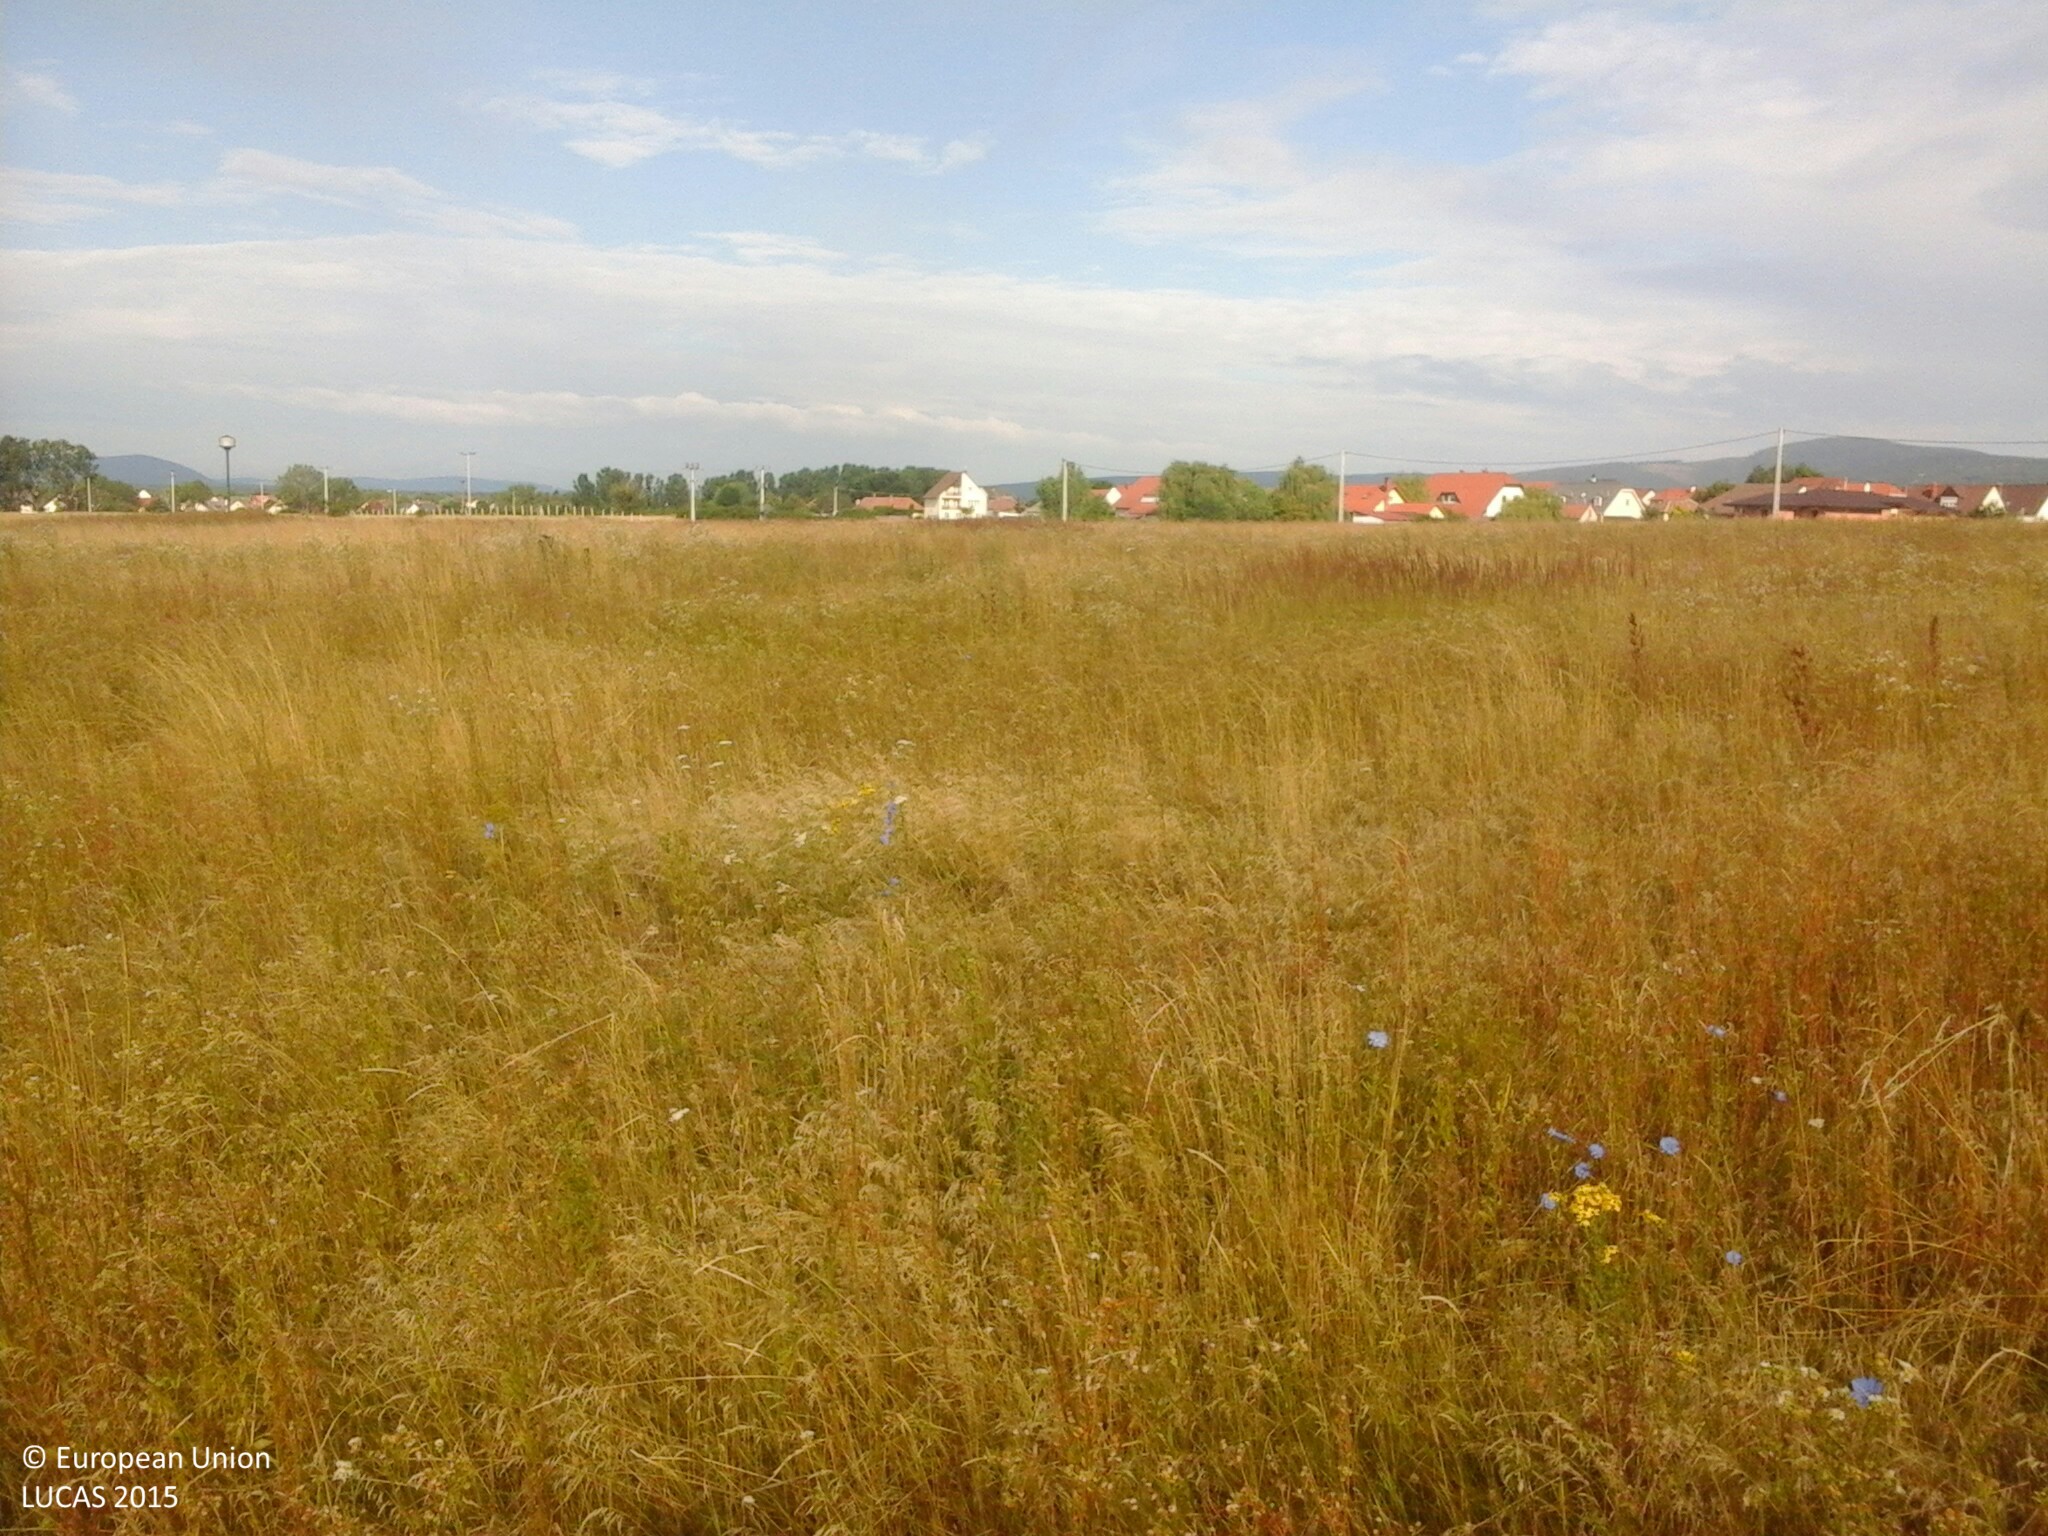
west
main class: Grassland
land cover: Grassland without tree/shrub cover
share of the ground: > 75 %
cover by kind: herbaceous plants 100 %
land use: Agriculture (excluding fallow land and kitchen gardens)
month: July
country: HU
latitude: 47.1397
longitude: 17.9602
